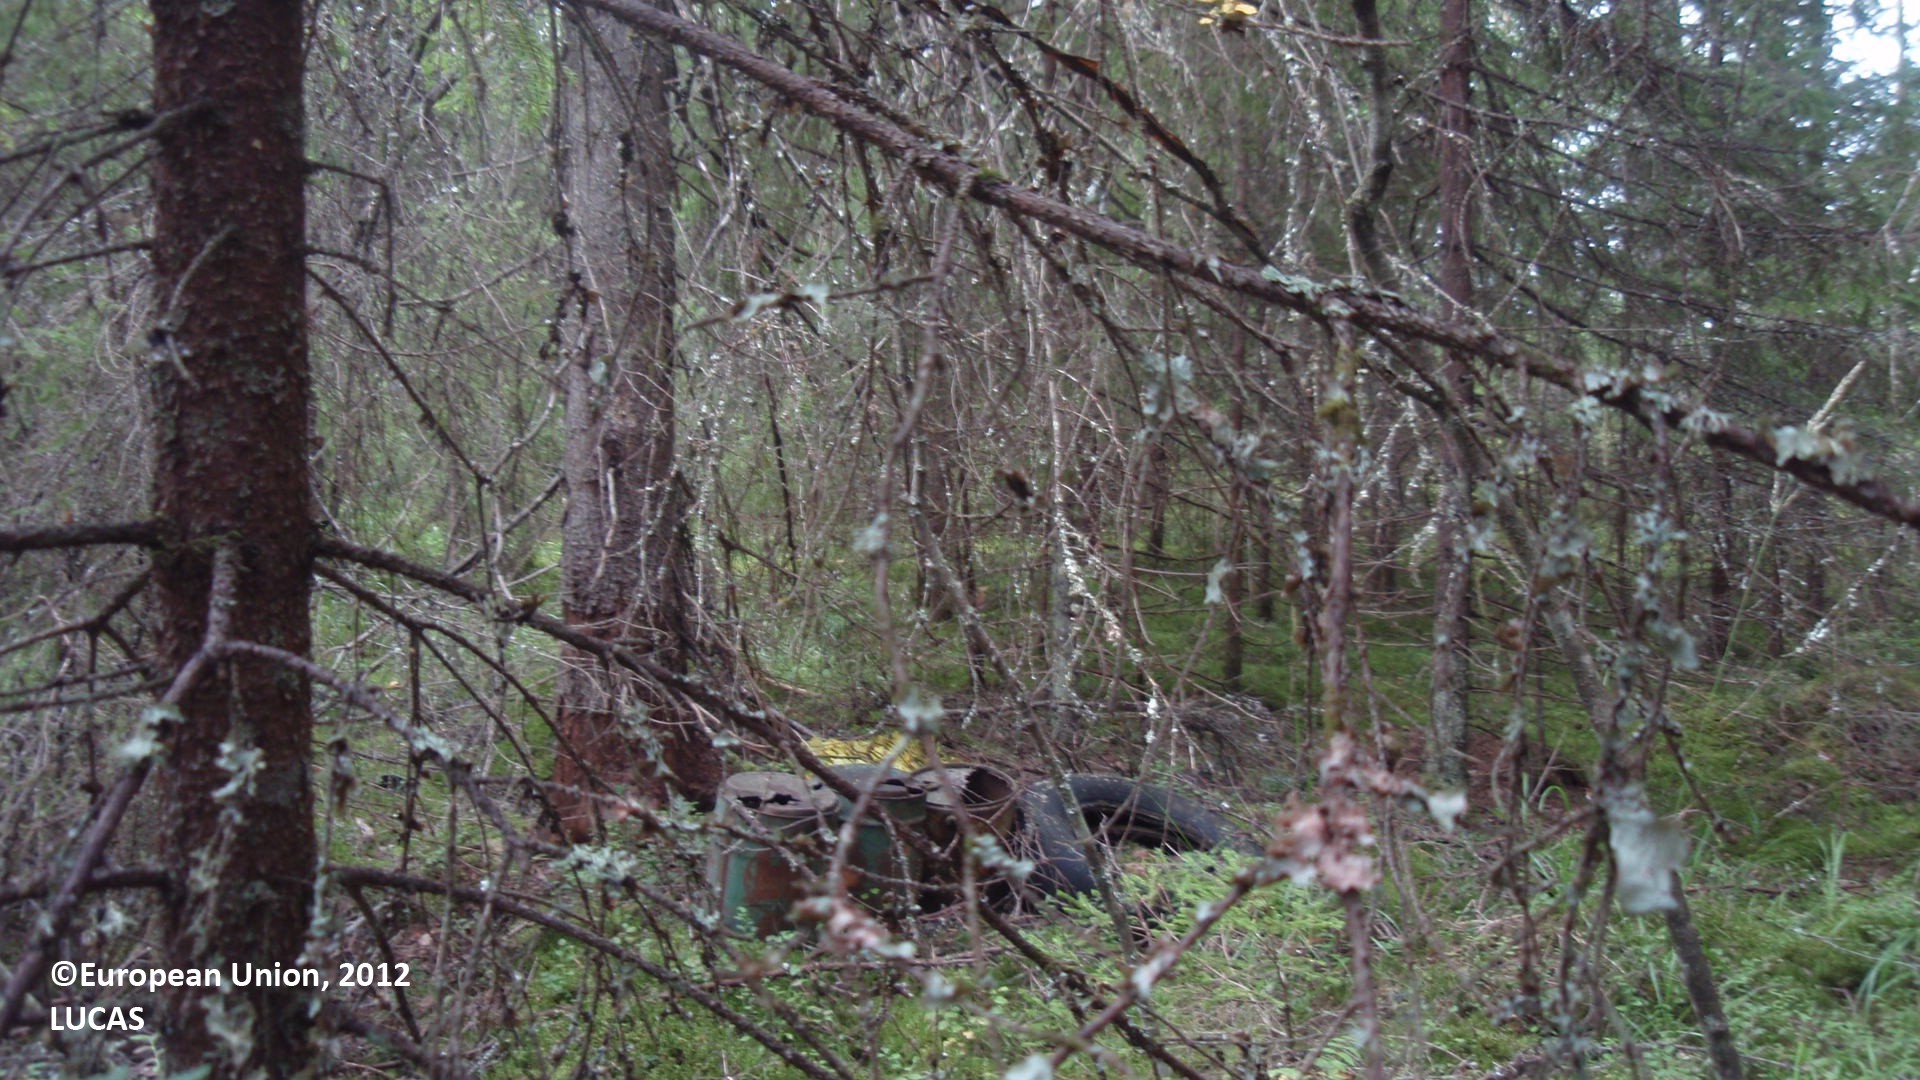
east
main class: Woodland
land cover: Spruce dominated mixed woodland
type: boreal forest
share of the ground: 50 - 75 %
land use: Forestry
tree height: > 5 m
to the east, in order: Spruce dominated mixed woodland; Pine dominated mixed woodland; Tracks; Shrubland with sparse tree cover; Pine dominated mixed woodland
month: August
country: FI
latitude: 60.8375
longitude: 27.4571
